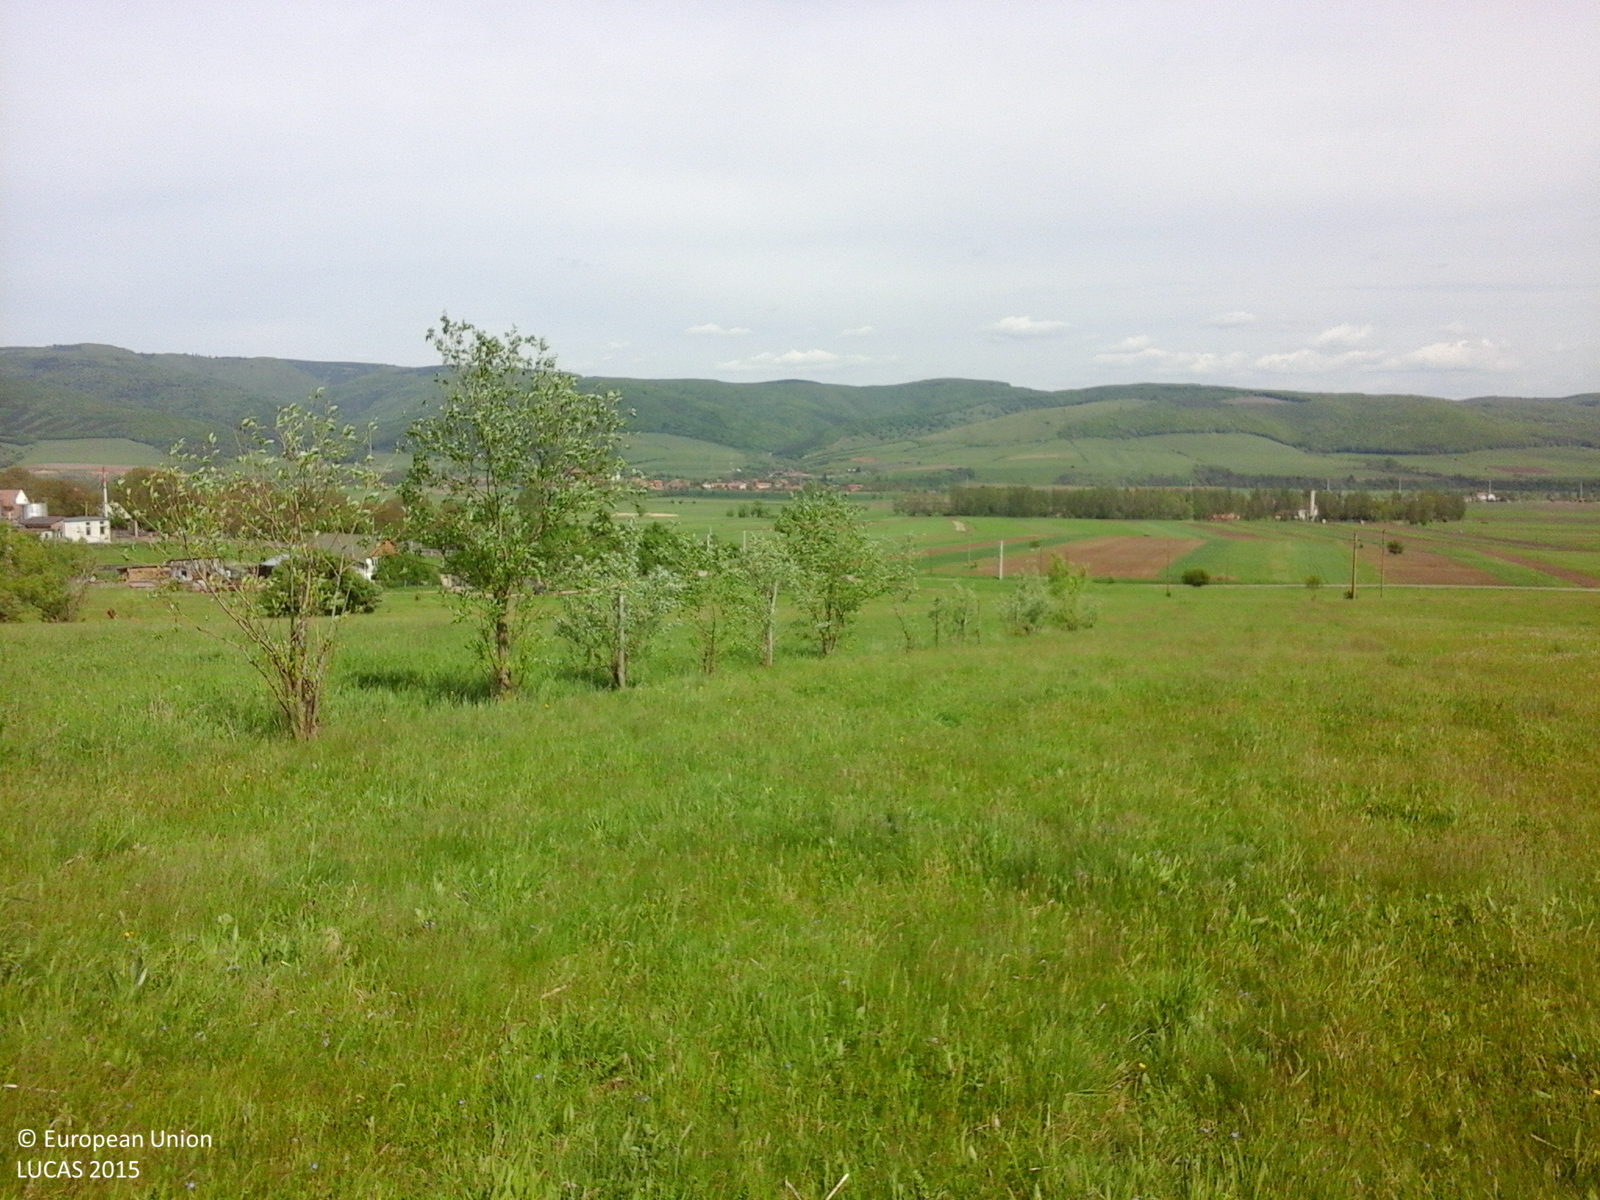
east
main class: Grassland
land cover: Grassland without tree/shrub cover
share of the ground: > 75 %
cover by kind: herbaceous plants 100 %
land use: Agriculture (excluding fallow land and kitchen gardens)
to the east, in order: Grassland without tree/shrub cover; Lines of trees; Other leguminous and mixtures for fodder; Grassland without tree/shrub cover
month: May
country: RO
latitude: 45.9541
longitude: 25.8135
